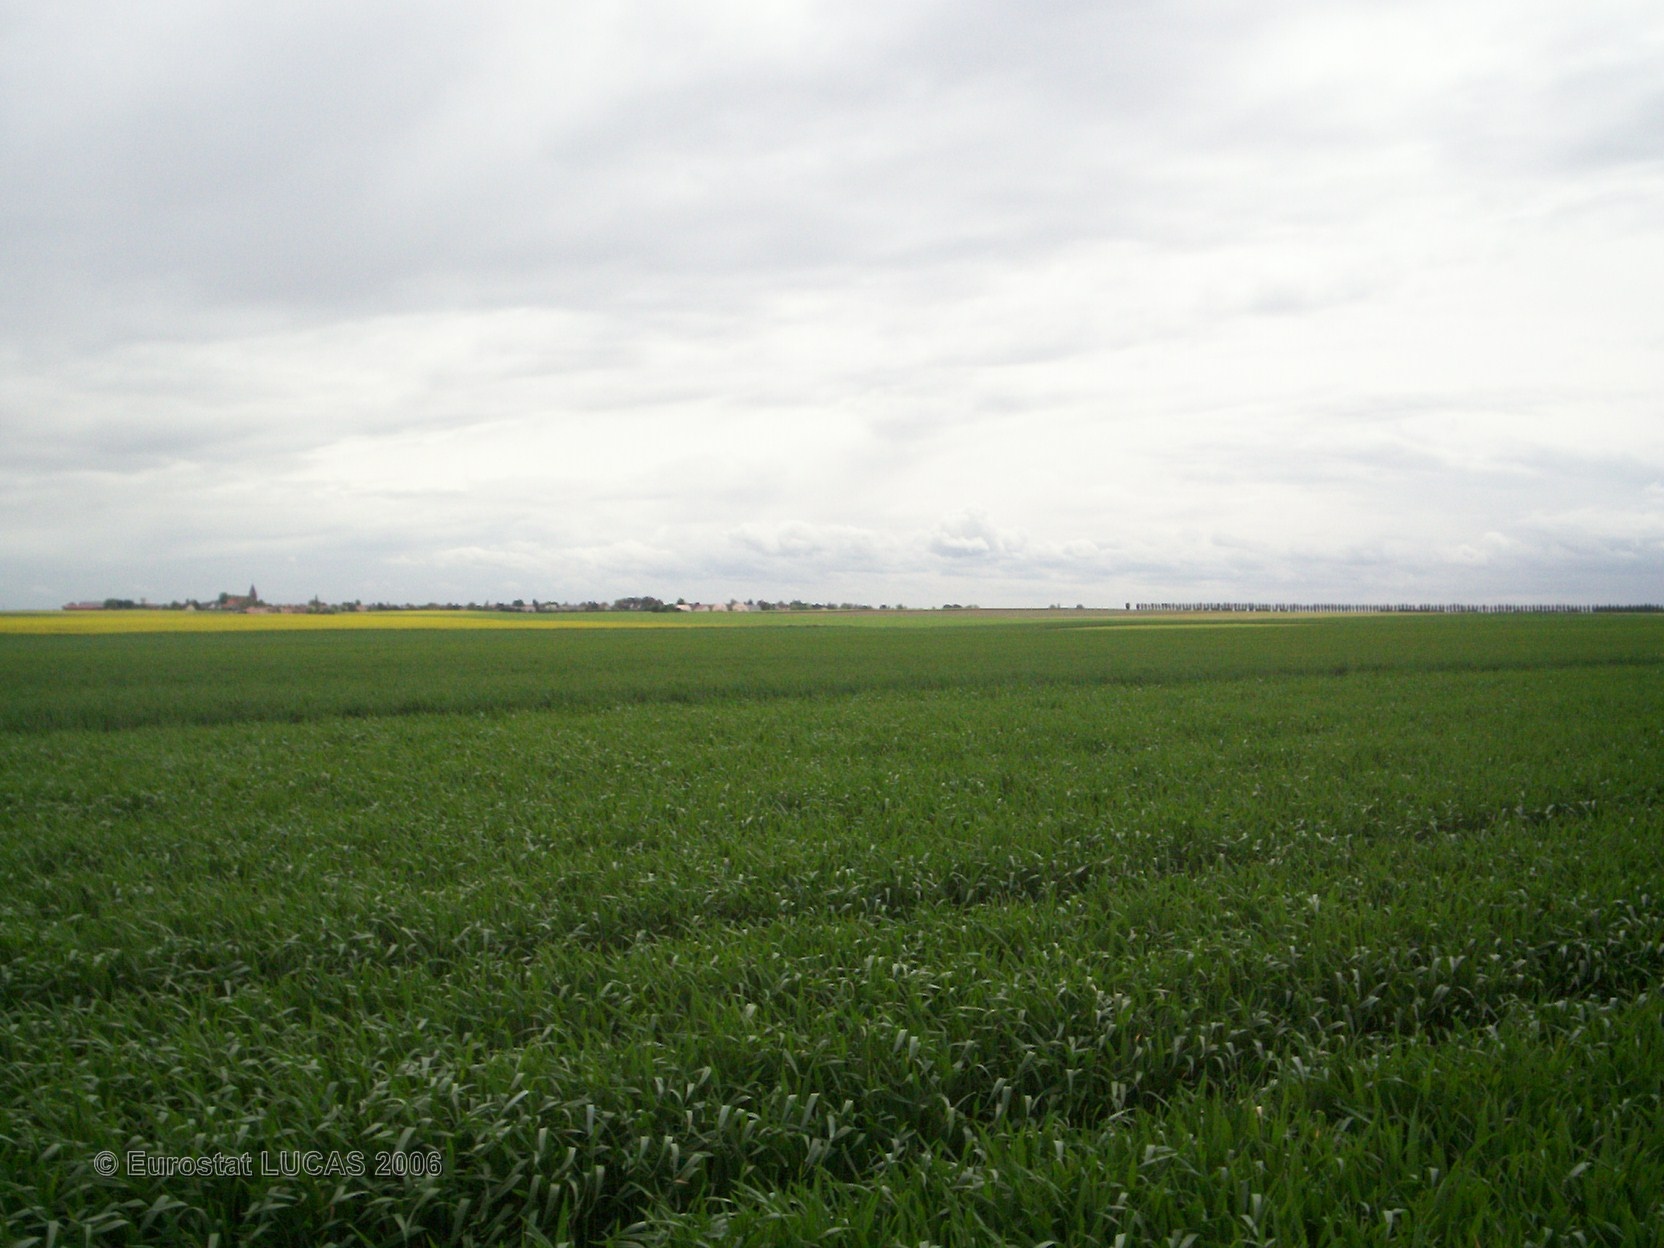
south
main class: Cropland
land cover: Common wheat
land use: Agriculture (excluding fallow land and kitchen gardens)
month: May
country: FR
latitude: 49.1256
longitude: 2.7957
